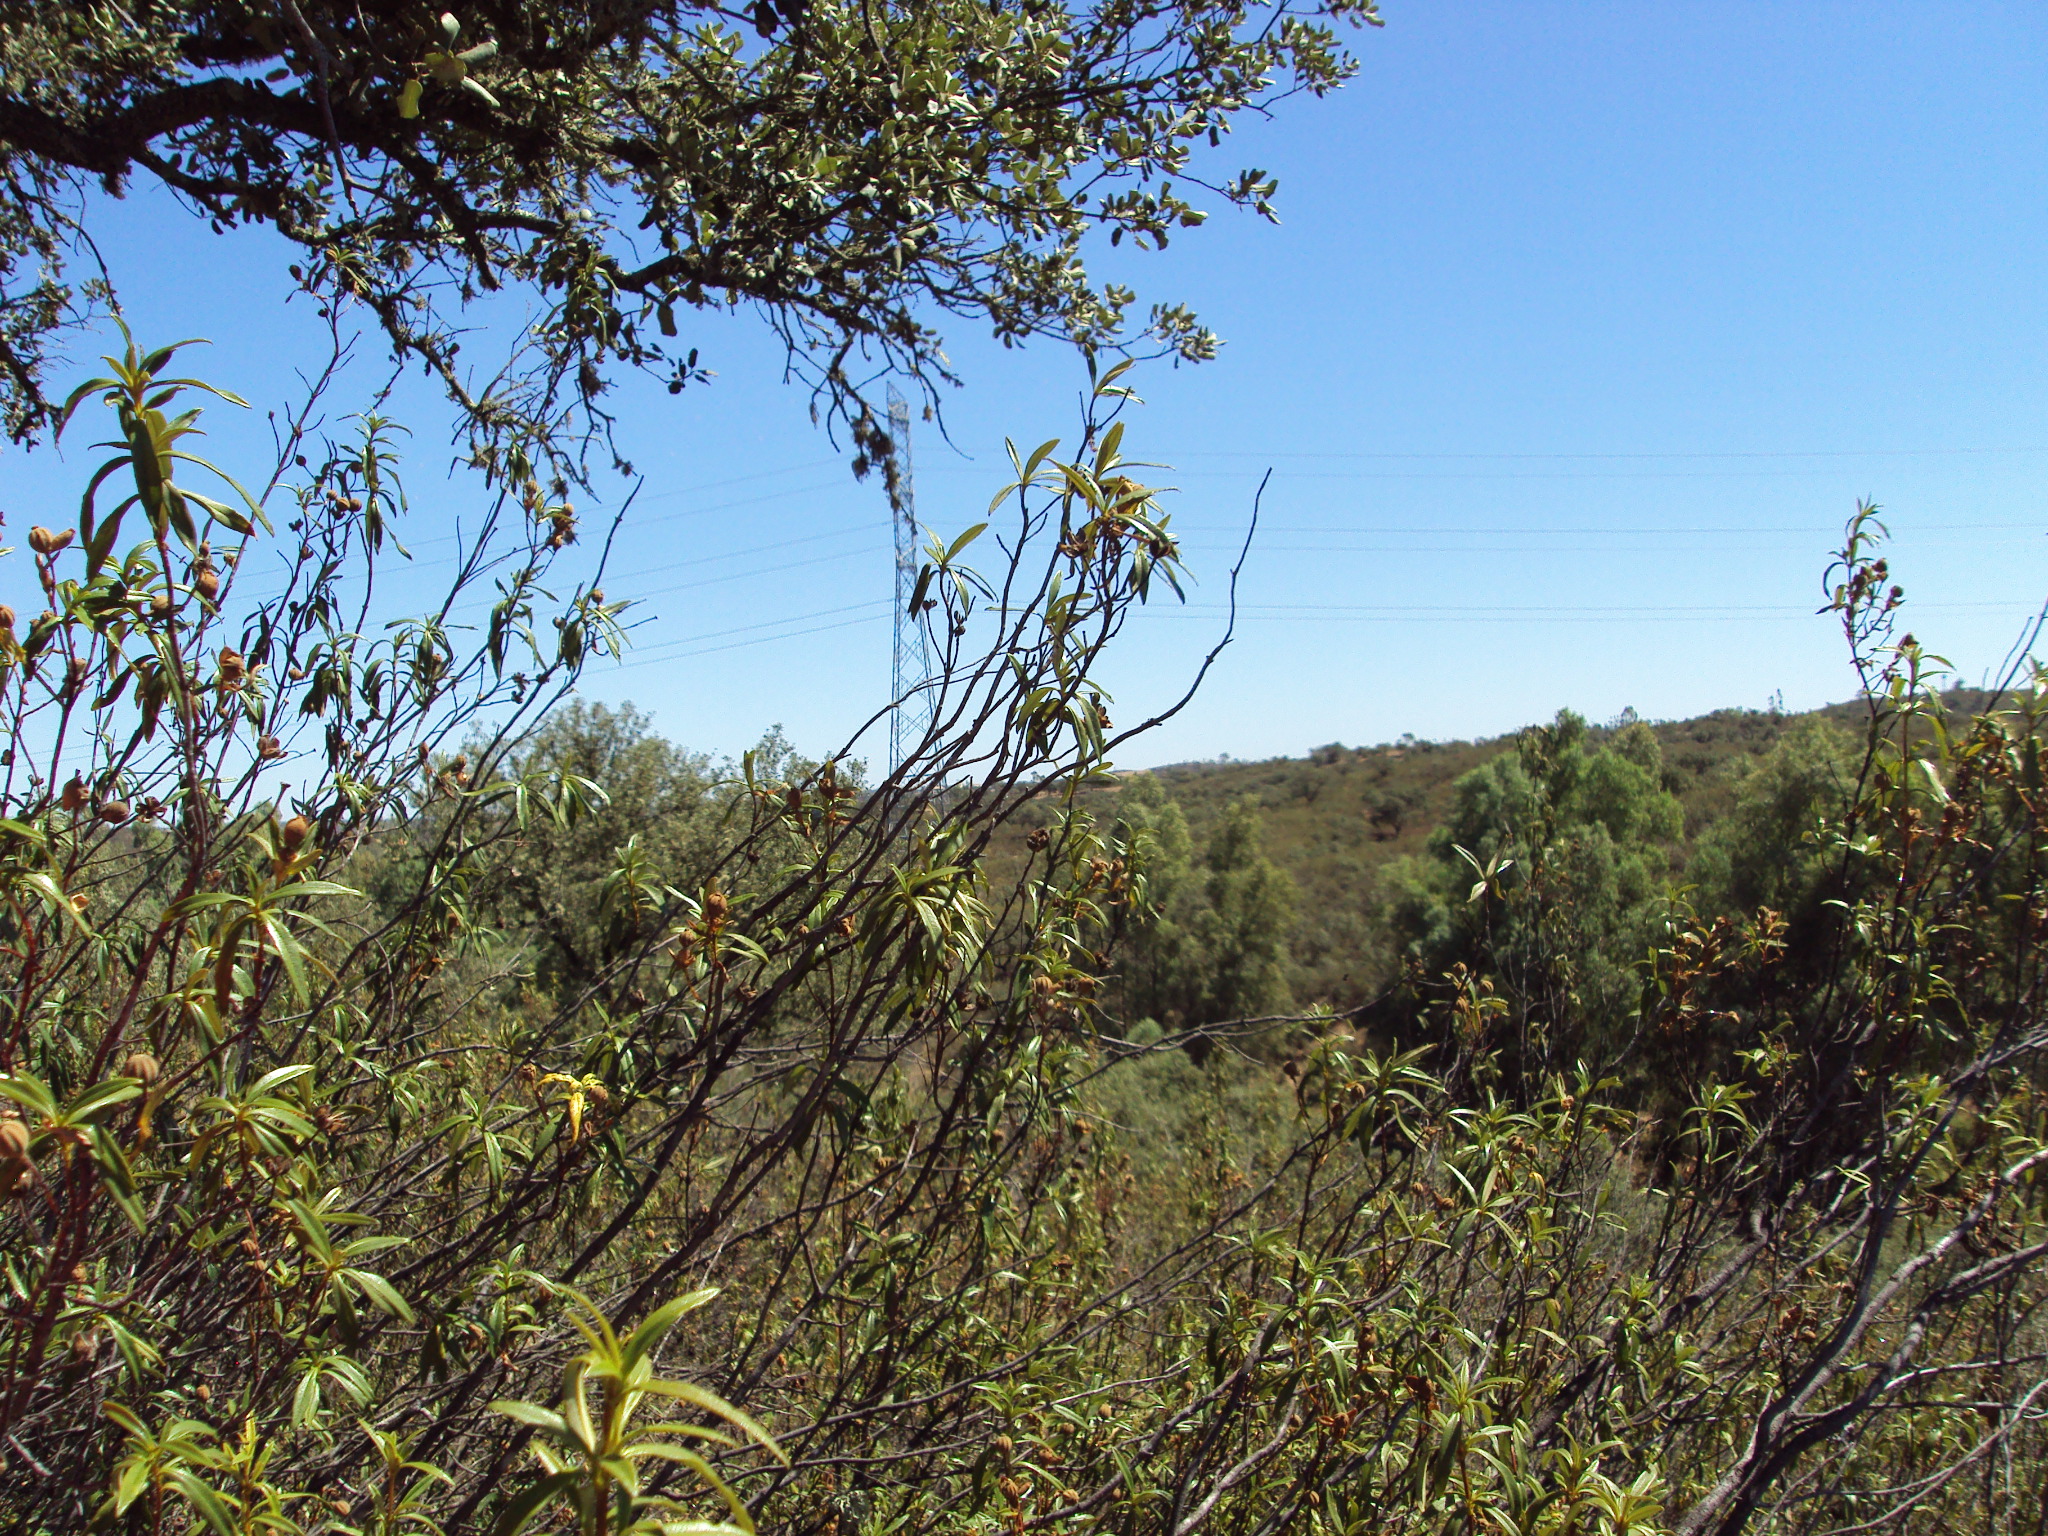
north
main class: Woodland
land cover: Broadleaved woodland
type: broadleaved evergreen forest
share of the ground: 10 - 25 %
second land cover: Spontaneously vegetated surfaces
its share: > 75 %
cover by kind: shrubs 80 %, broadleaved forest trees 20 %
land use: Forestry
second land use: Agriculture (excluding fallow land and kitchen gardens)
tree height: < 5 m
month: July
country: ES
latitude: 37.4507
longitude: -7.0569
